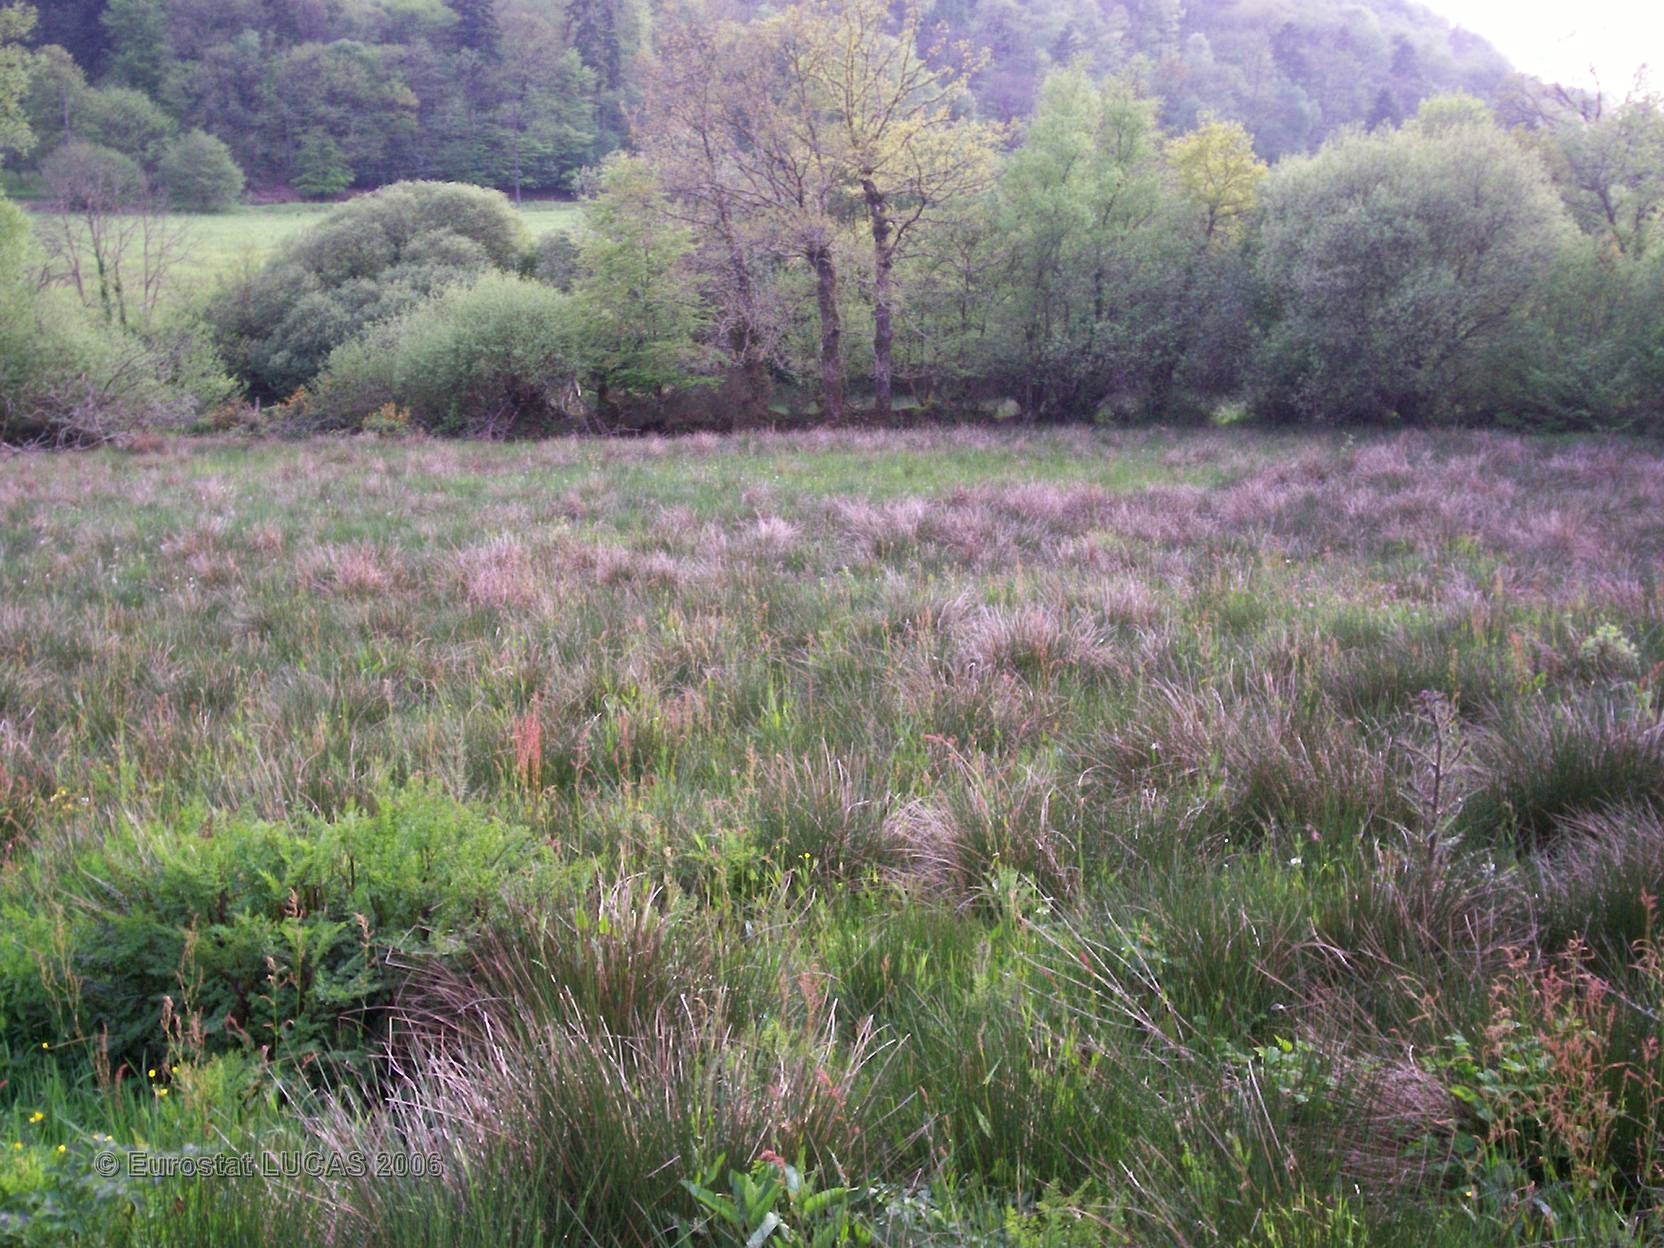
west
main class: Grassland
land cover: Grassland without tree/shrub cover
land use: Agriculture (excluding fallow land and kitchen gardens)
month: May
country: FR
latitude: 48.1568
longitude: -3.9185
